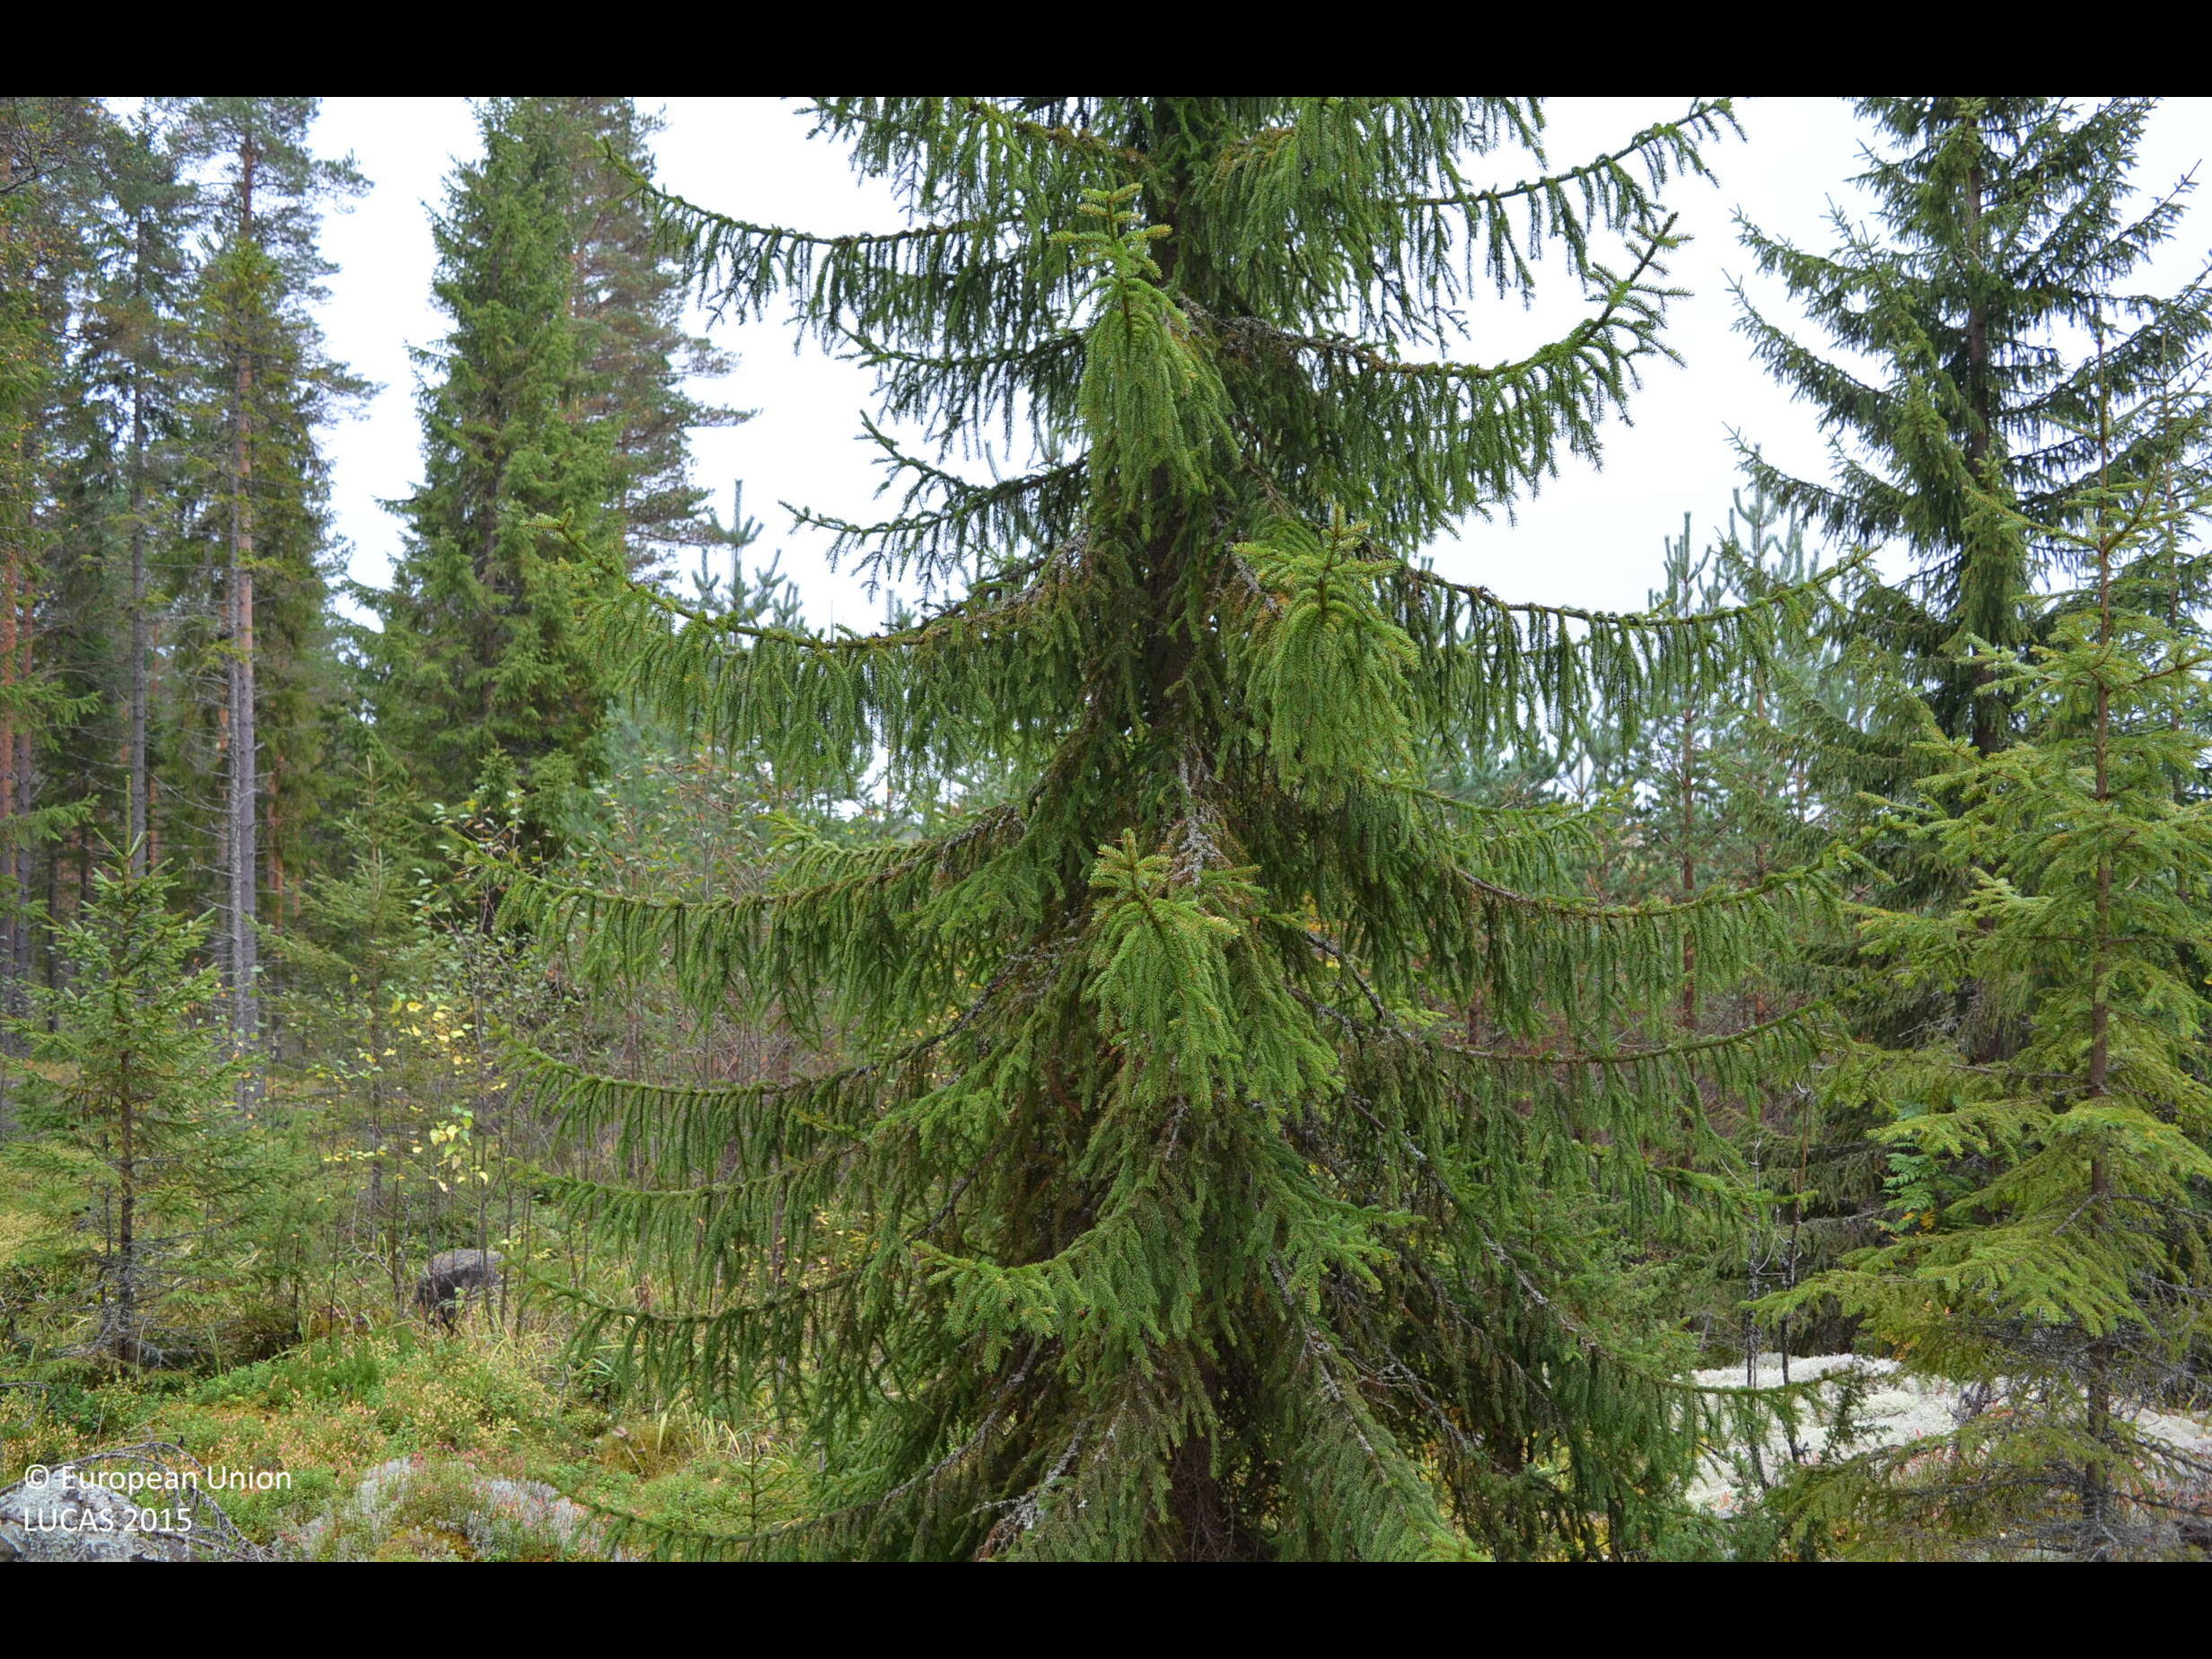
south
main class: Woodland
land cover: Other coniferous woodland
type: boreal forest
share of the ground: 50 - 75 %
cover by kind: coniferous forest trees 50 %, lichens and mosses 25 %, broadleaved forest trees 10 %, shrubs 10 %, unconsolidated bare surface 5 %
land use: Forestry
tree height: > 5 m
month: September
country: FI
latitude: 62.4380
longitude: 23.7332
